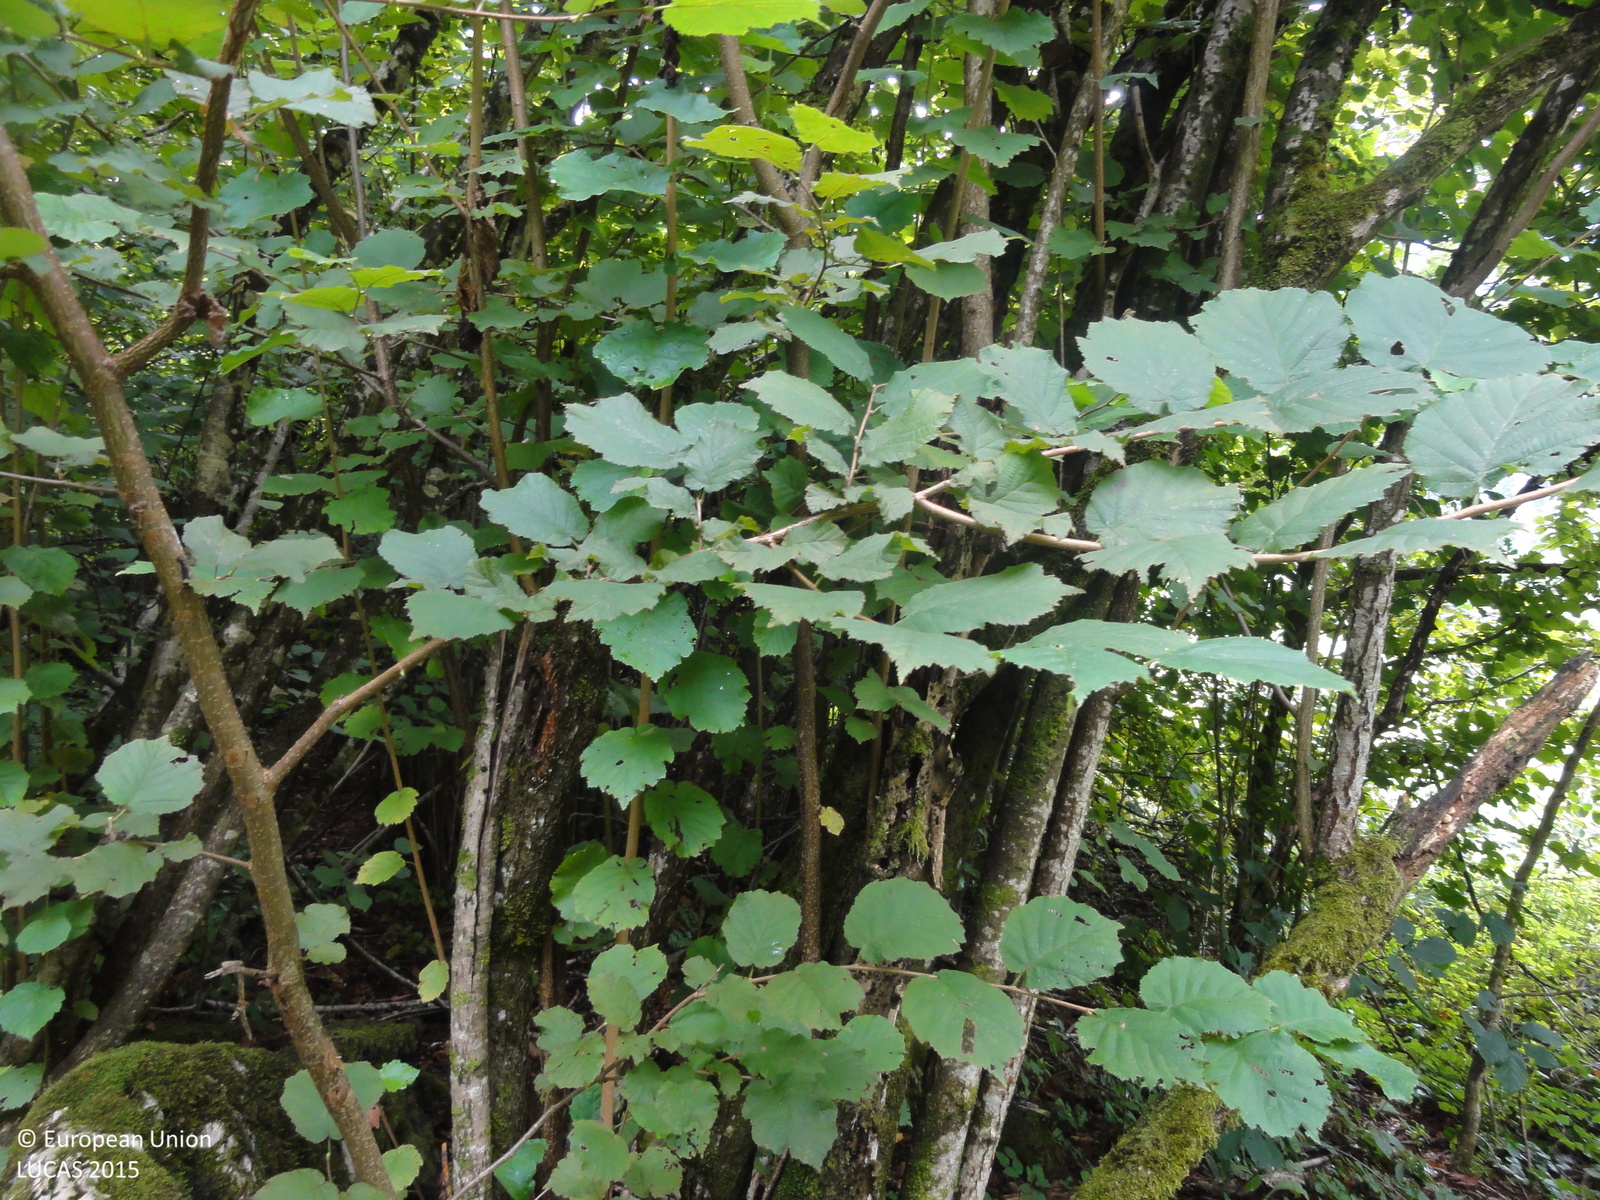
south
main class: Woodland
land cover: Broadleaved woodland
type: beech forest
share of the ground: 25 - 50 %
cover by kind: shrubs 70 %, broadleaved forest trees 30 %
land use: Forestry
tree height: > 5 m
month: August
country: SI
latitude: 45.7448
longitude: 15.0477
